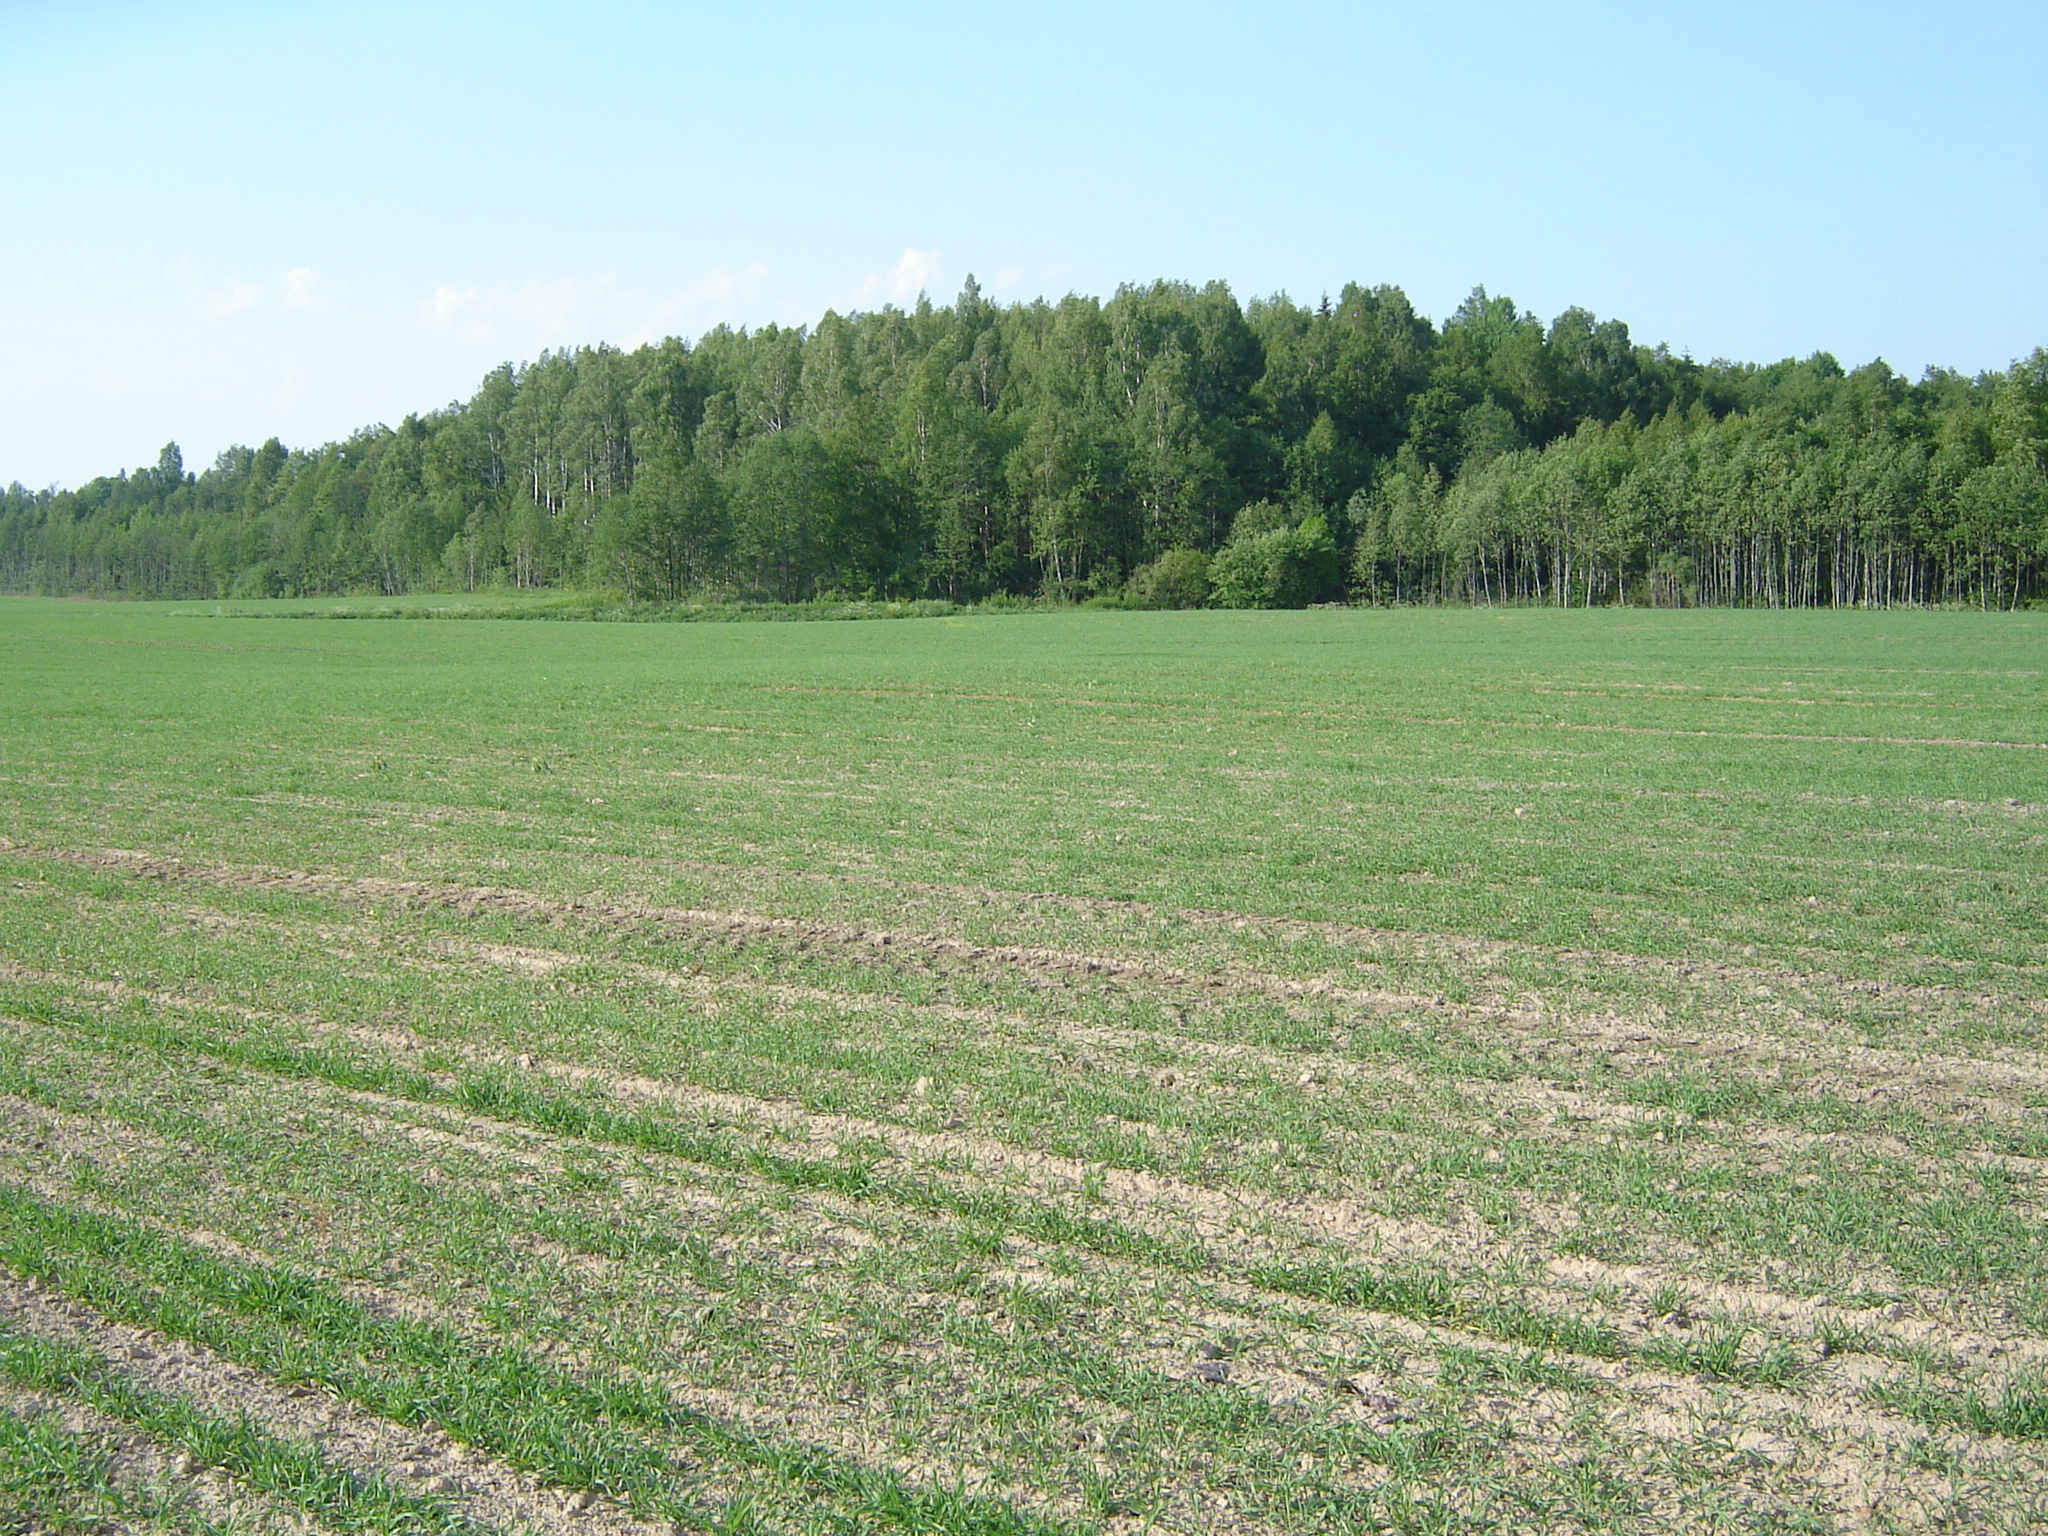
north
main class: Cropland
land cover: Barley
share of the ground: 50 - 75 %
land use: Agriculture (excluding fallow land and kitchen gardens)
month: June
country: LT
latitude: 55.8733
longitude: 25.2519
